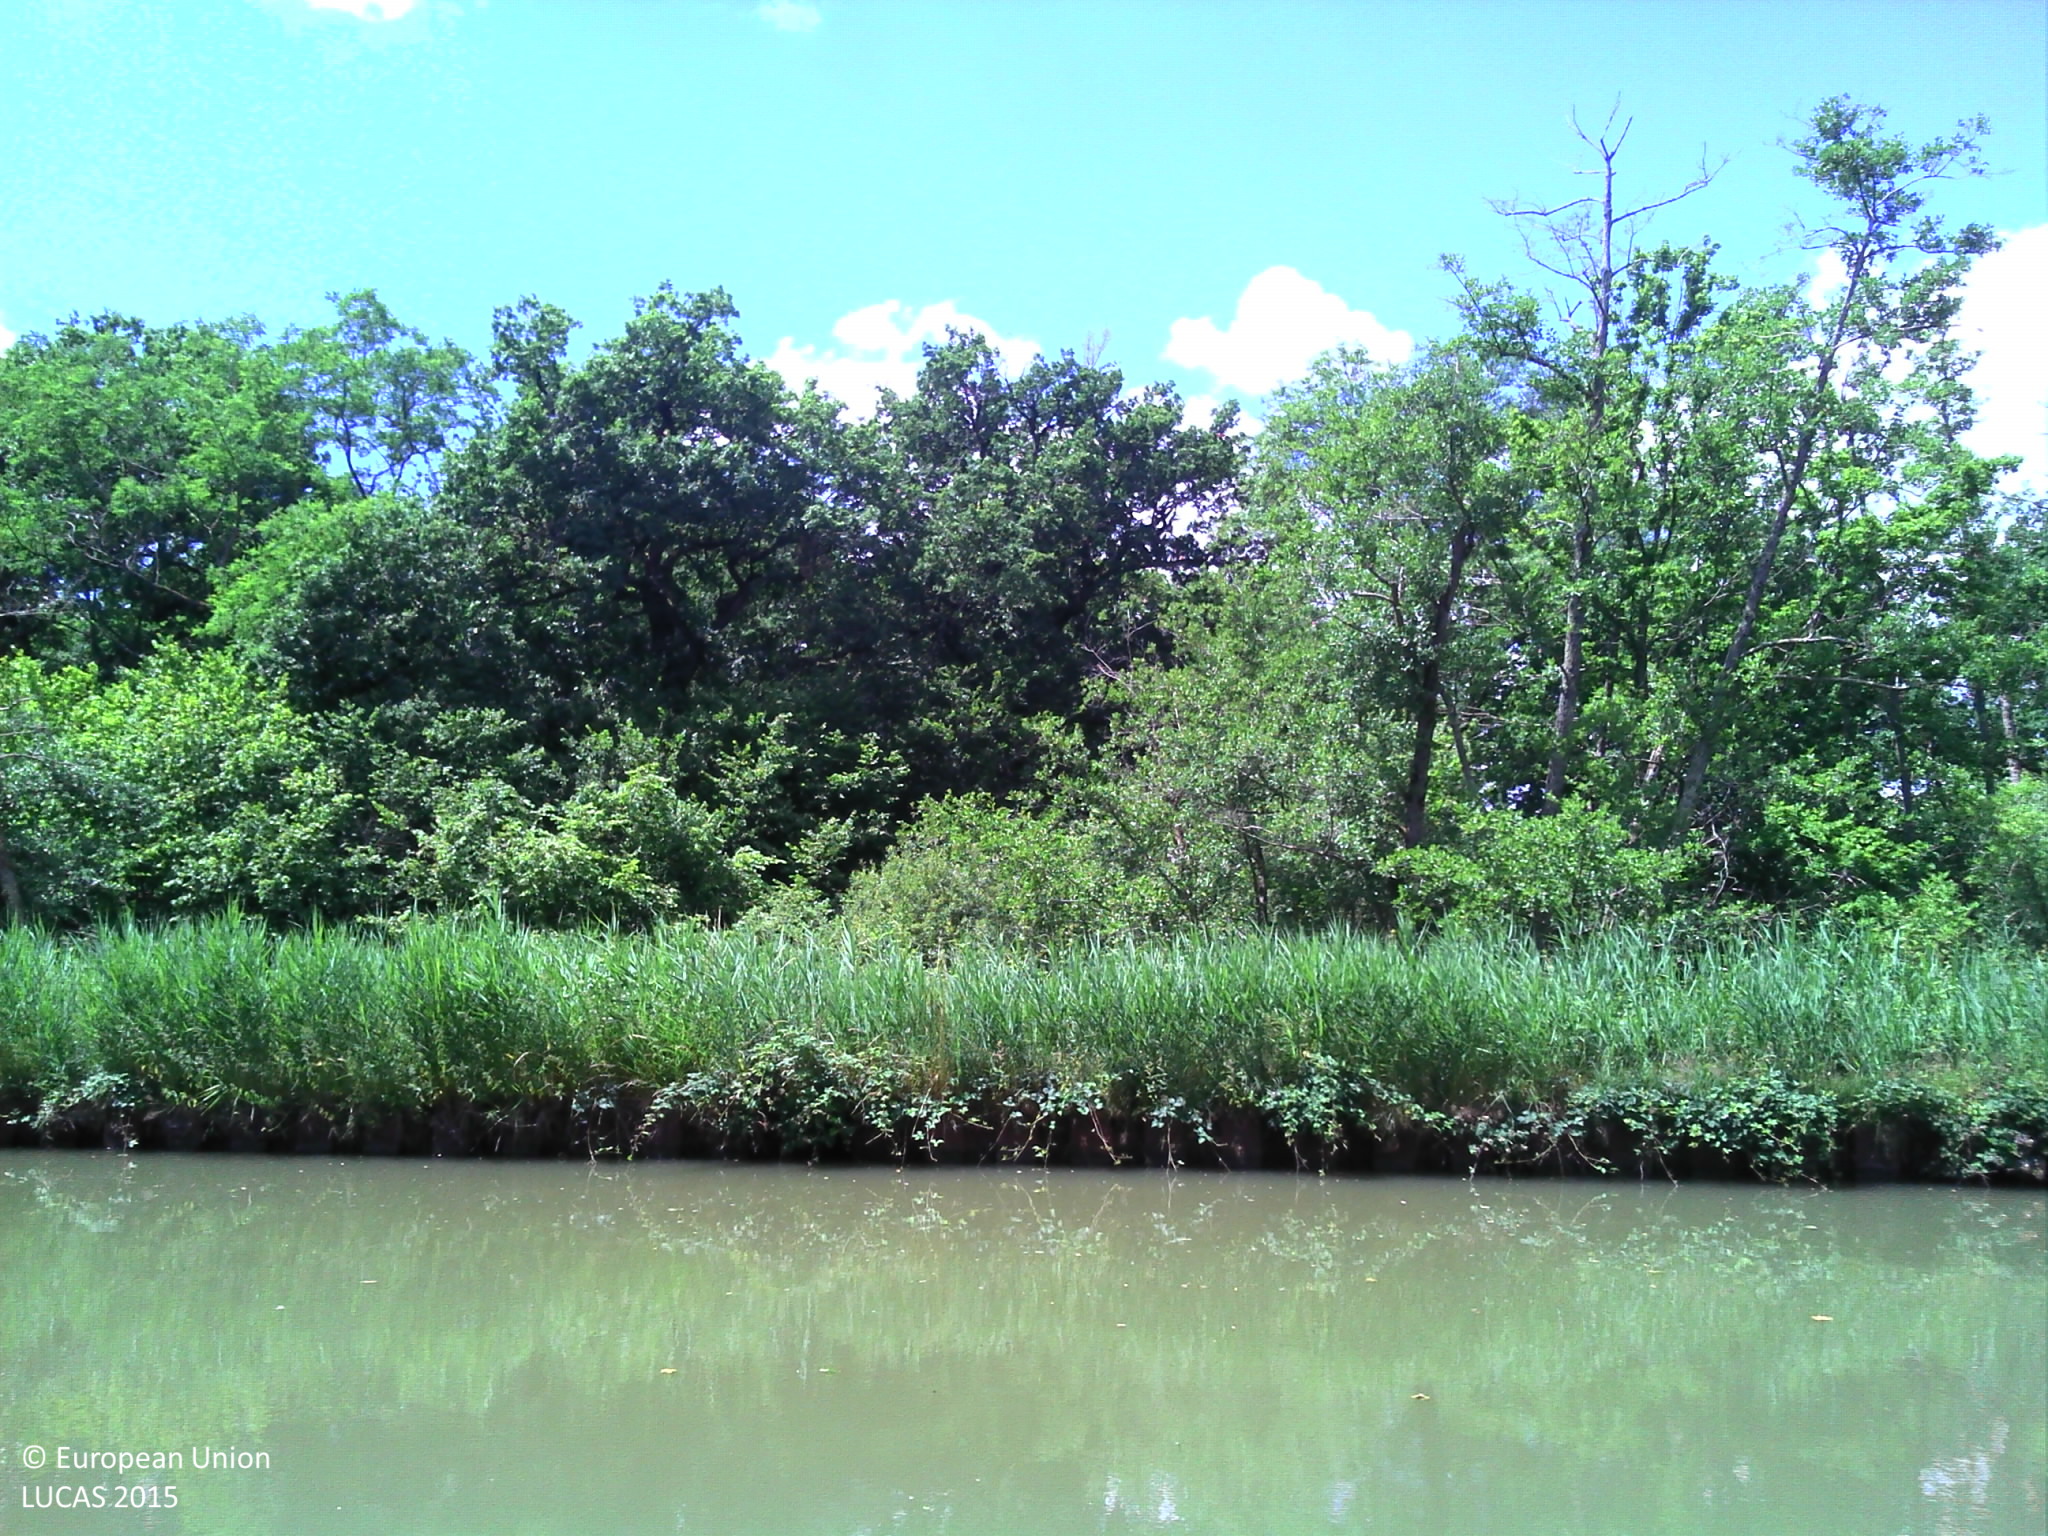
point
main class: Woodland
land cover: Broadleaved woodland
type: acidophilous oak and oak-birch forest
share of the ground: > 75 %
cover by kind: broadleaved forest trees 90 %, shrubs 5 %, herbaceous plants 5 %
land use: Semi-natural and natural areas not in use
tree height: > 5 m
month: June
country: FR
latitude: 46.6673
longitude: 3.6335
